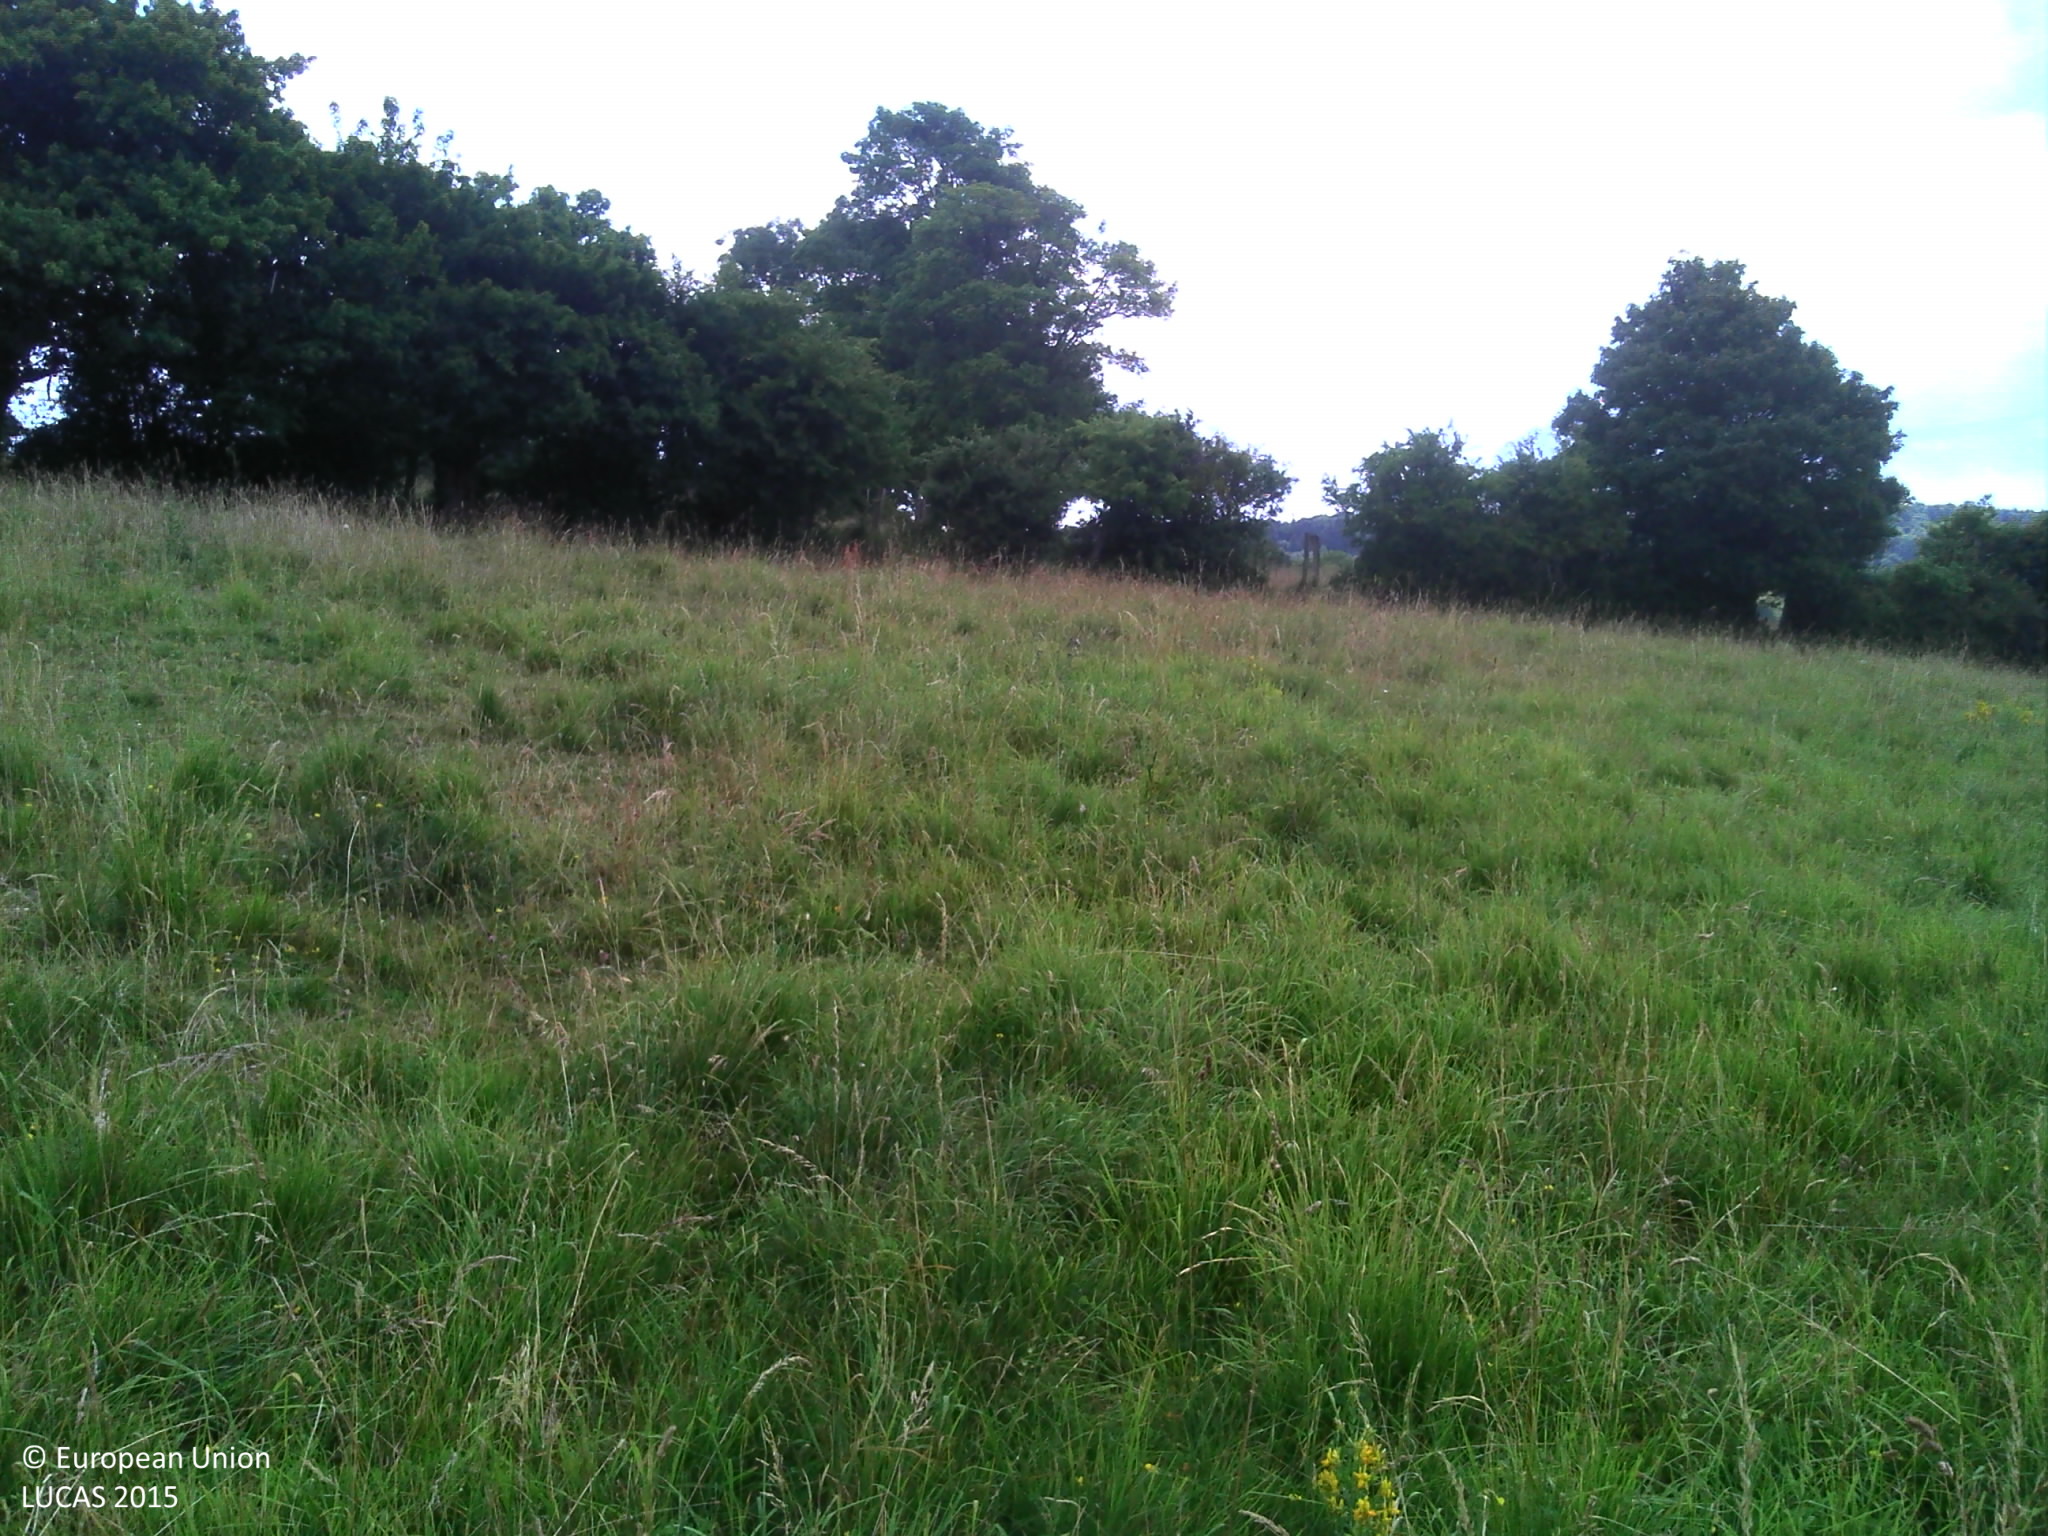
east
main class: Grassland
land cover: Grassland without tree/shrub cover
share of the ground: > 75 %
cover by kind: herbaceous plants 100 %
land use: Agriculture (excluding fallow land and kitchen gardens)
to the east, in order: Grassland without tree/shrub cover; Fences; Abandoned hedges; Grassland without tree/shrub cover; Broadleaved woodland; Fences; Grassland without tree/shrub cover; Electric lines; Grassland without tree/shrub cover; Fences; Abandoned hedges; Grassland without tree/shrub cover
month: July
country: FR
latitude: 49.0033
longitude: 0.0317
